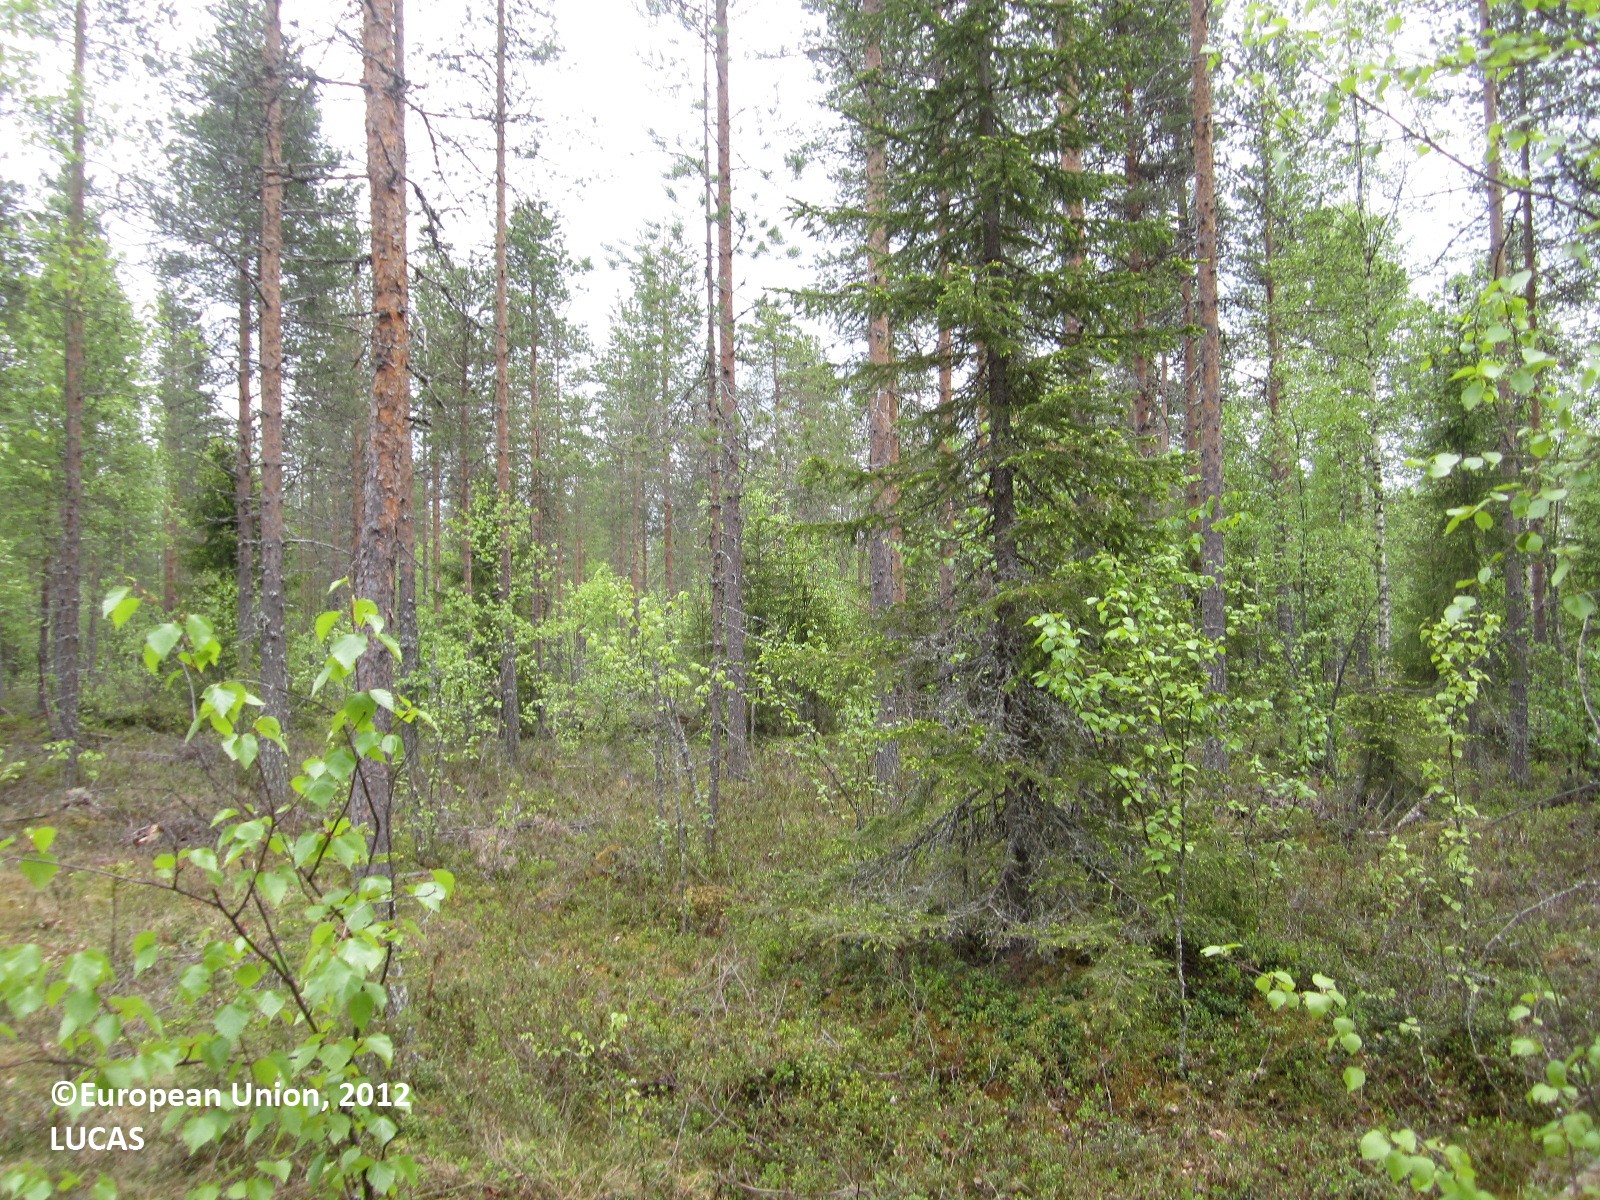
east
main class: Woodland
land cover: Pine dominated mixed woodland
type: boreal forest
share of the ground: 25 - 50 %
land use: Forestry
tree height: > 5 m
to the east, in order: Pine dominated mixed woodland; Tracks; Pine dominated mixed woodland; Ditches and canals; Pine dominated mixed woodland; Ditches and canals; Pine dominated mixed woodland; Tracks; Pine dominated mixed woodland; Ditches and canals; Grass margins; Pine dominated mixed woodland; Tracks; Pine dominated mixed woodland; Shrubland with sparse tree cover; Pine dominated mixed woodland; Ditches and canals; Grass margins; Tracks; Pine dominated mixed woodland; Pine dominated coniferous woodland
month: June
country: FI
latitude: 64.5480
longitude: 28.6370
